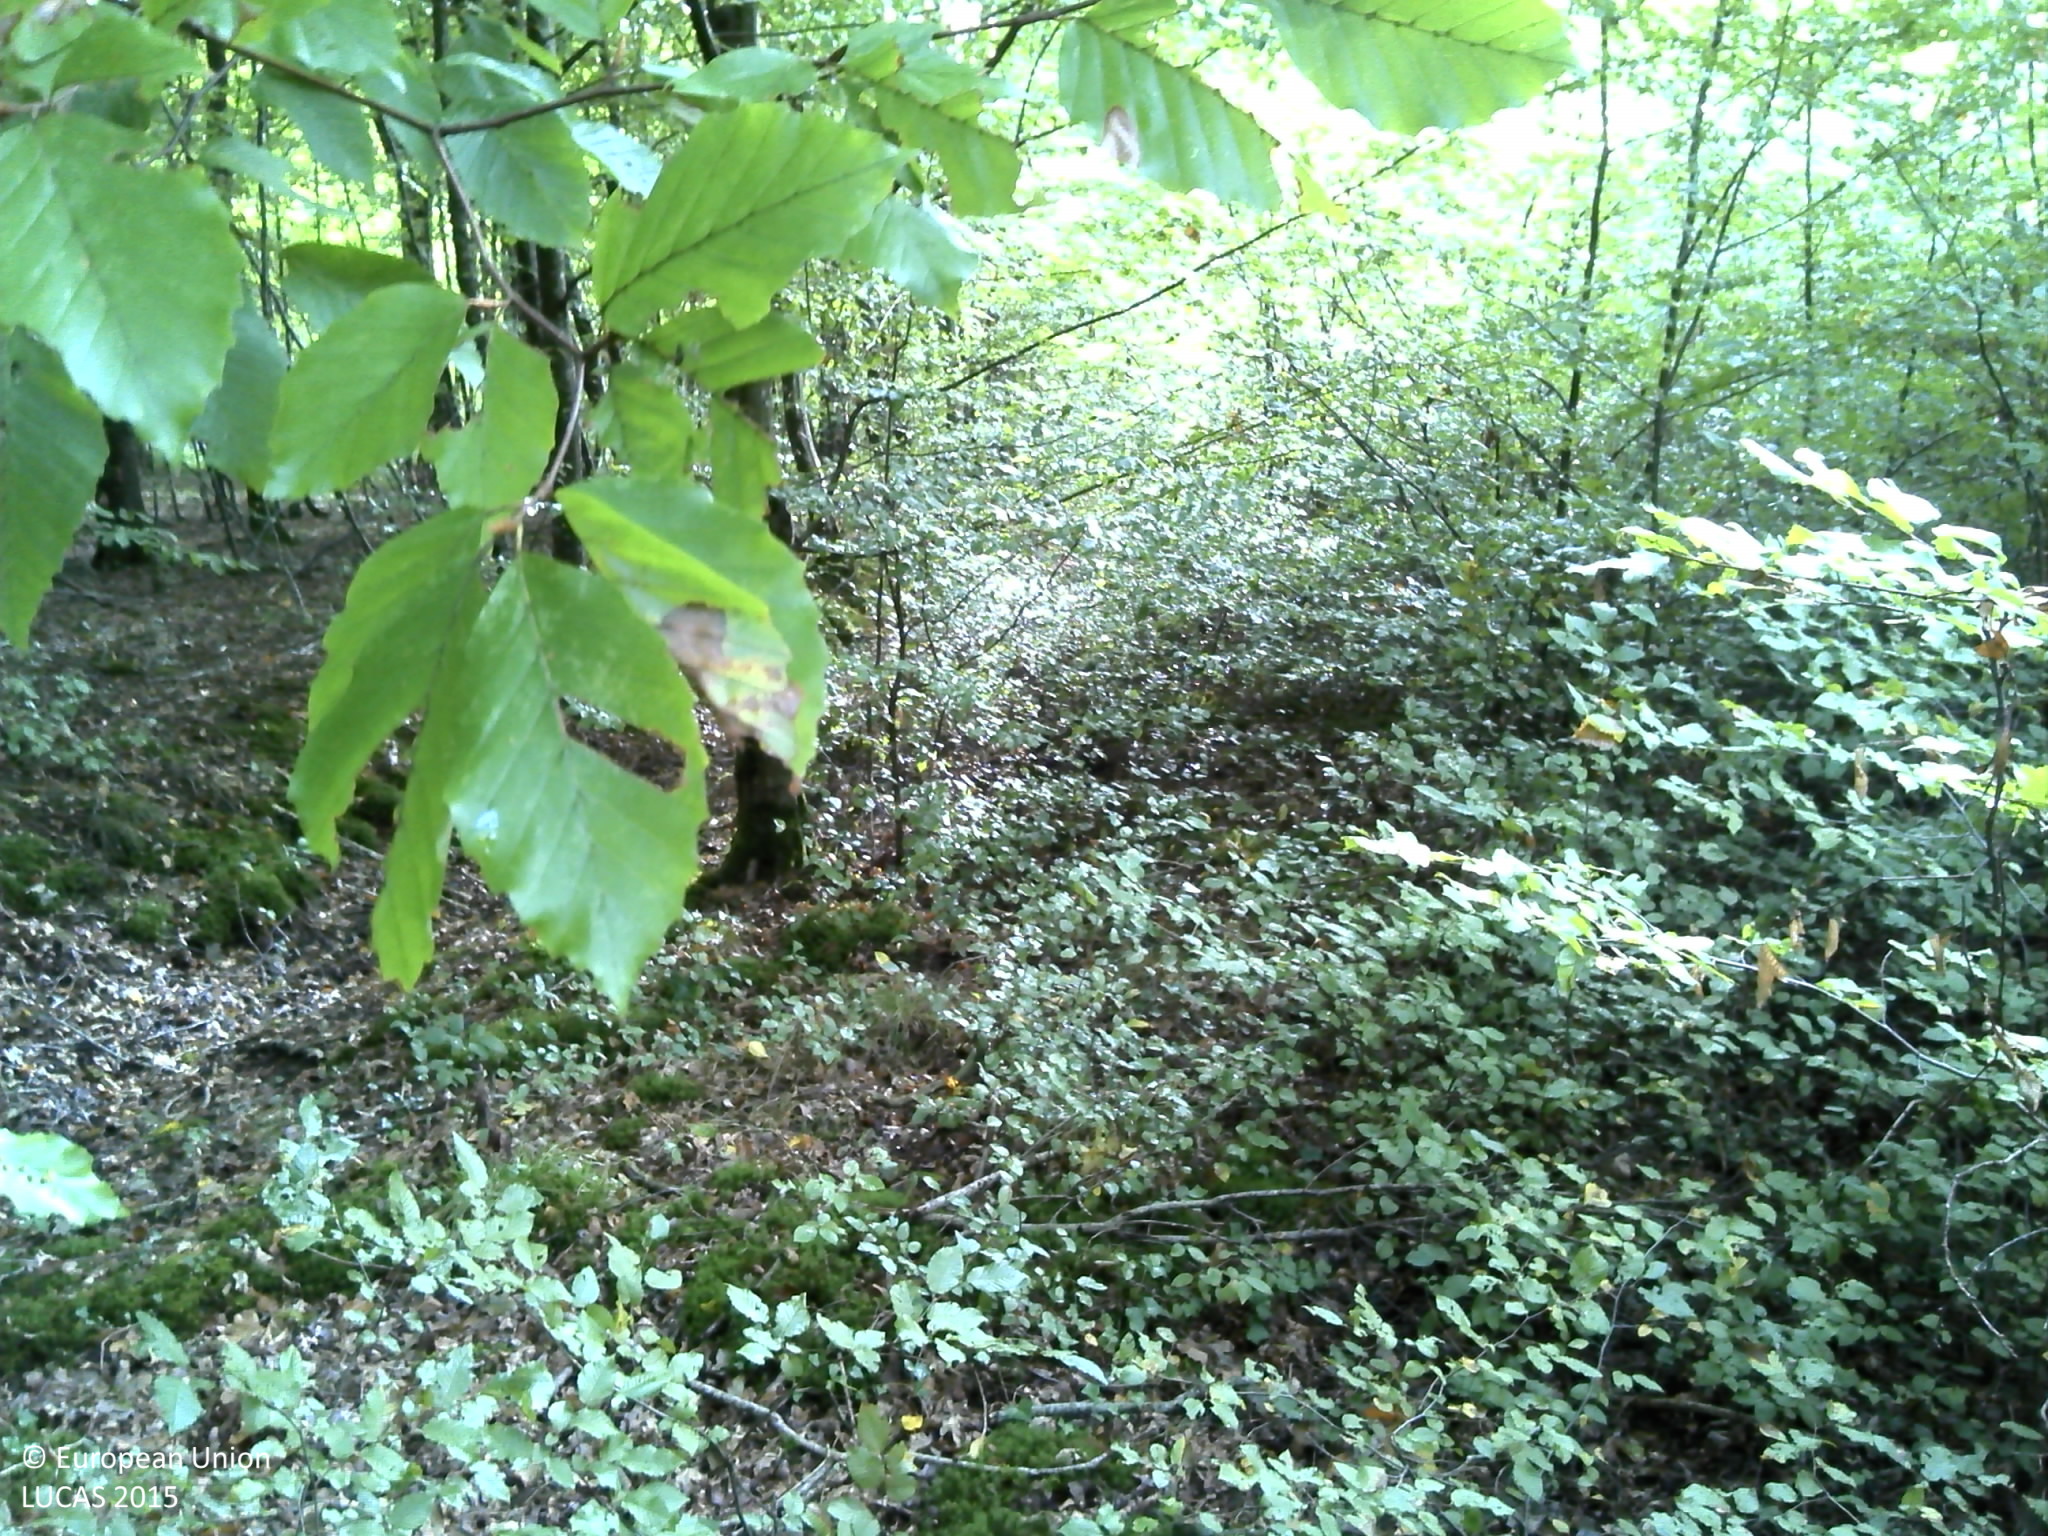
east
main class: Woodland
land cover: Broadleaved woodland
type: acidophilous oak and oak-birch forest
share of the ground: > 75 %
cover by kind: broadleaved forest trees 85 %, herbaceous plants 15 %
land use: Forestry
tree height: > 5 m
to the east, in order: Broadleaved woodland; Ditches and canals; Grass margins; Paved roads, cycling and walking lanes; Grass margins; Ditches and canals; Broadleaved woodland; Shrubland with sparse tree cover; Tracks; Shrubland with sparse tree cover
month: June
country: FR
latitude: 46.6919
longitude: 4.7577
